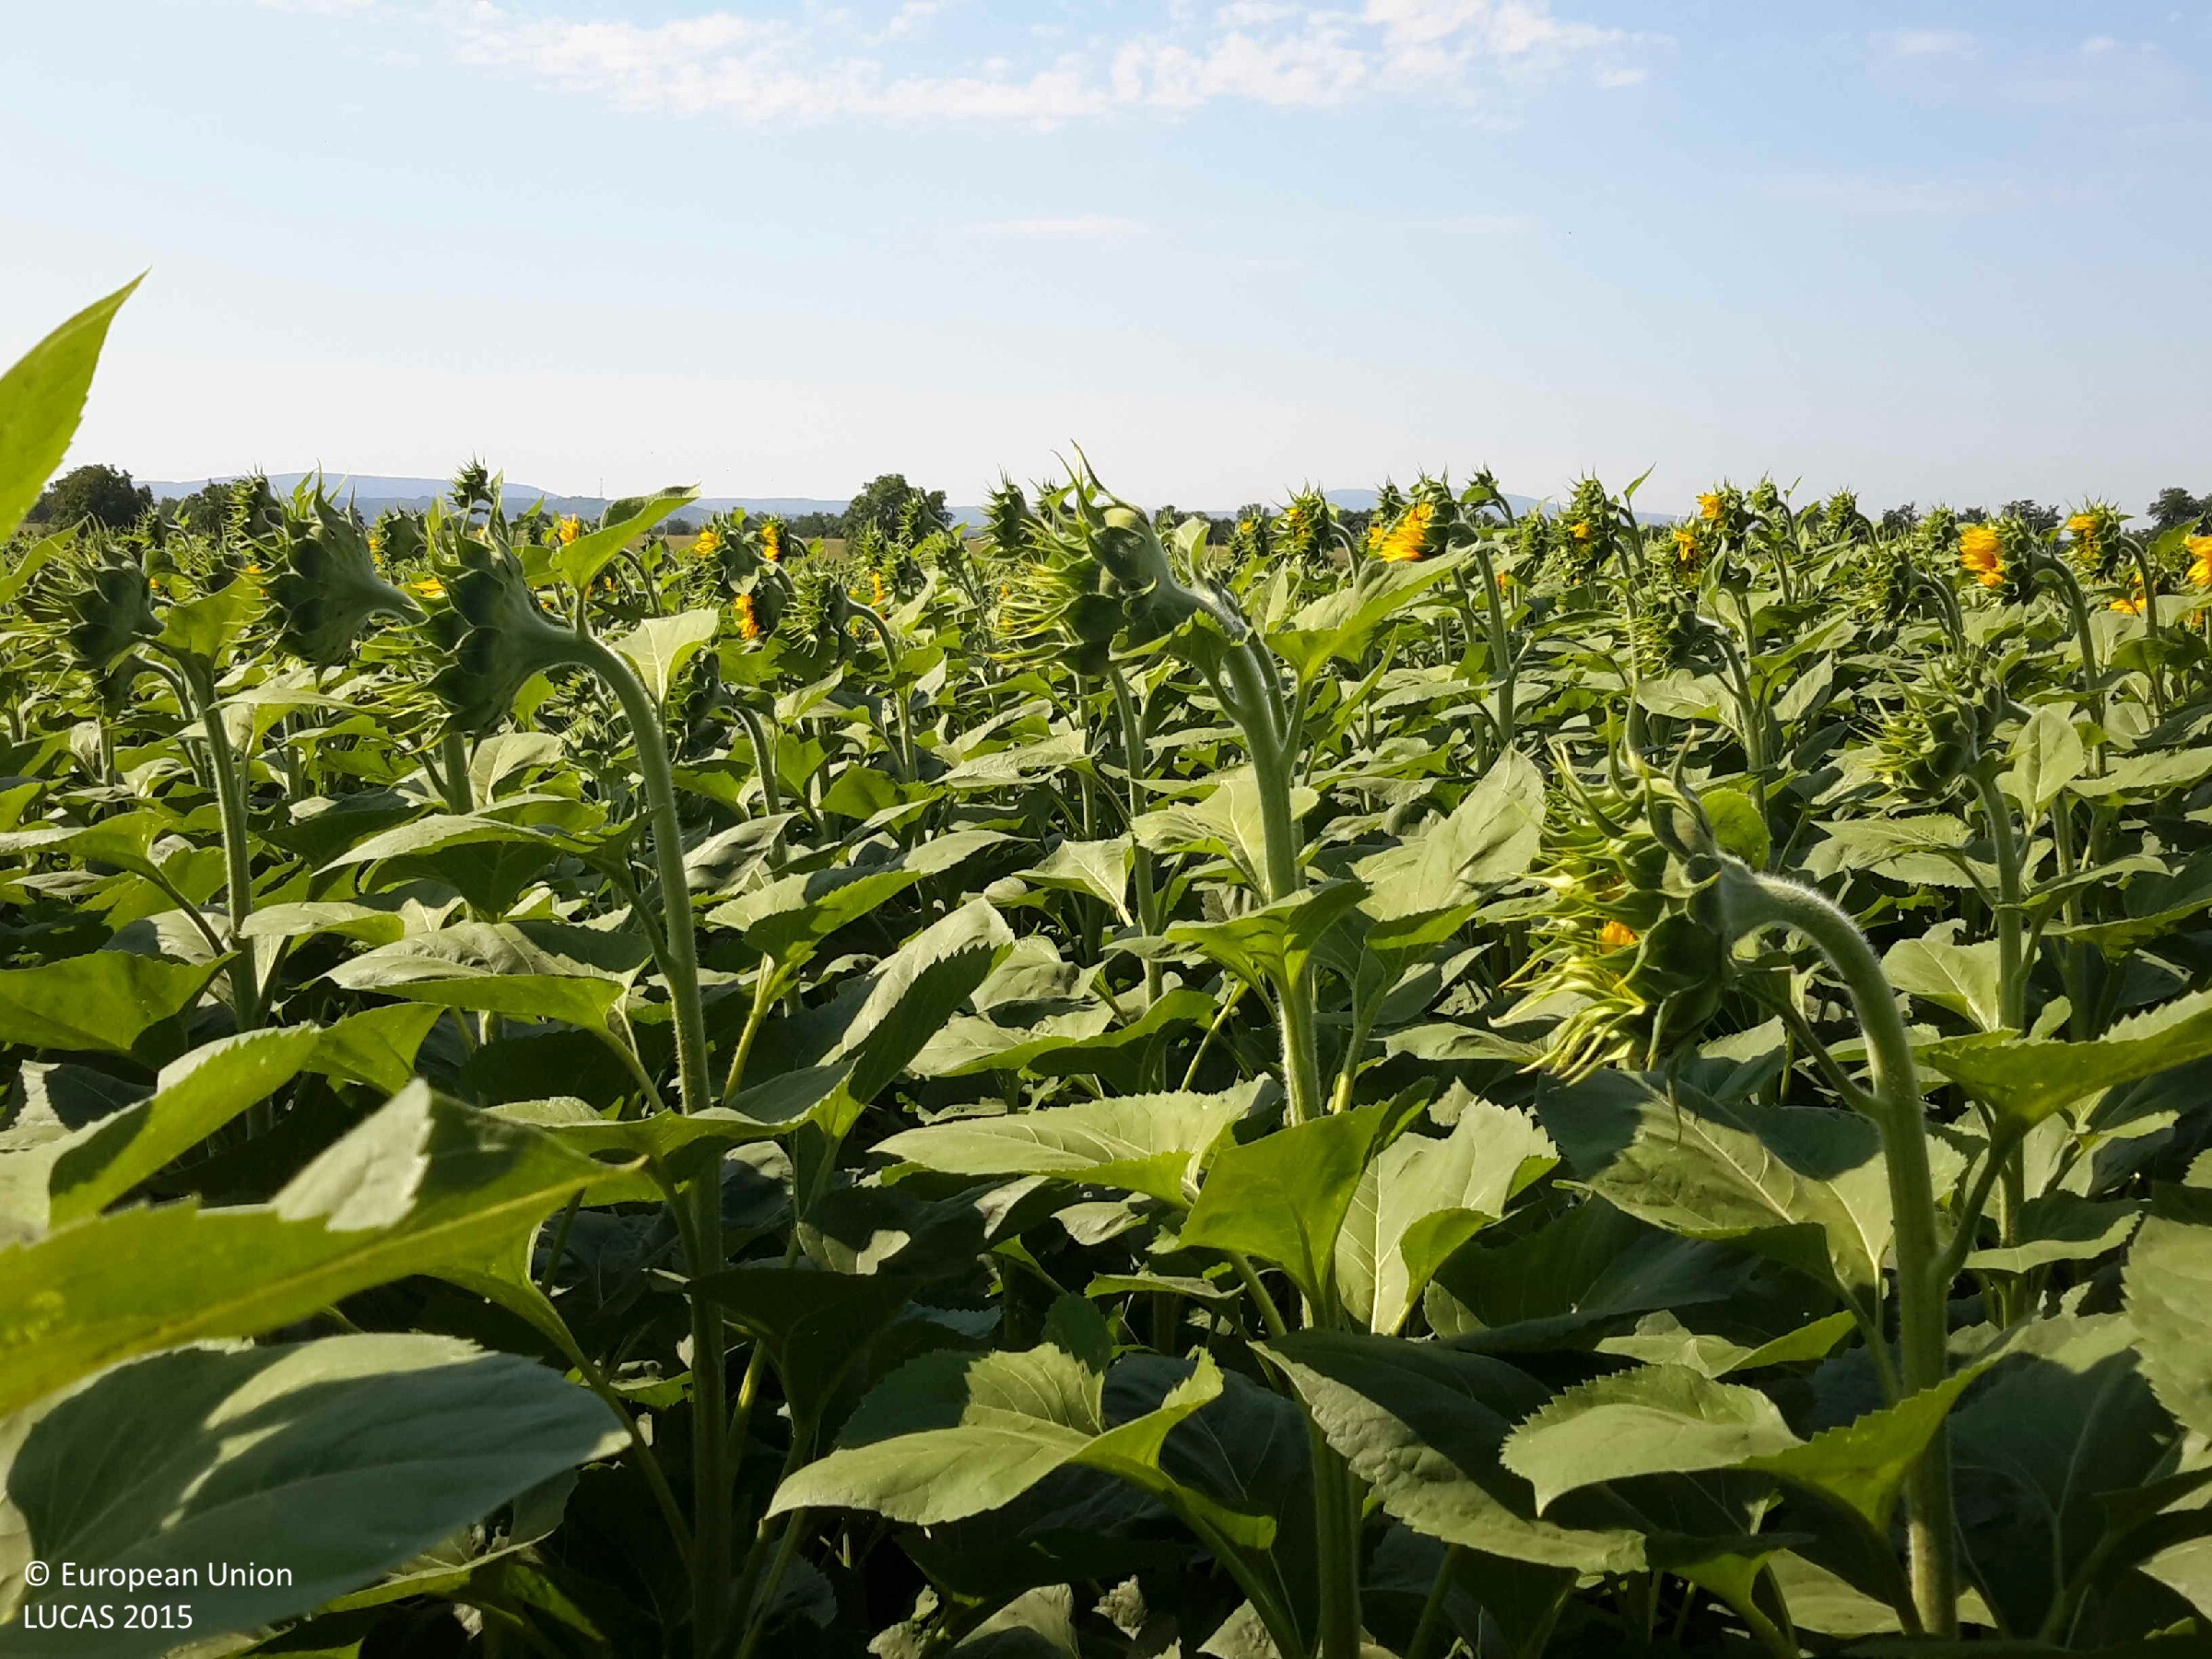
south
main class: Cropland
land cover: Sunflower
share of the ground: > 75 %
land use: Agriculture (excluding fallow land and kitchen gardens)
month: July
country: HU
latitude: 47.4751
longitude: 17.8251
